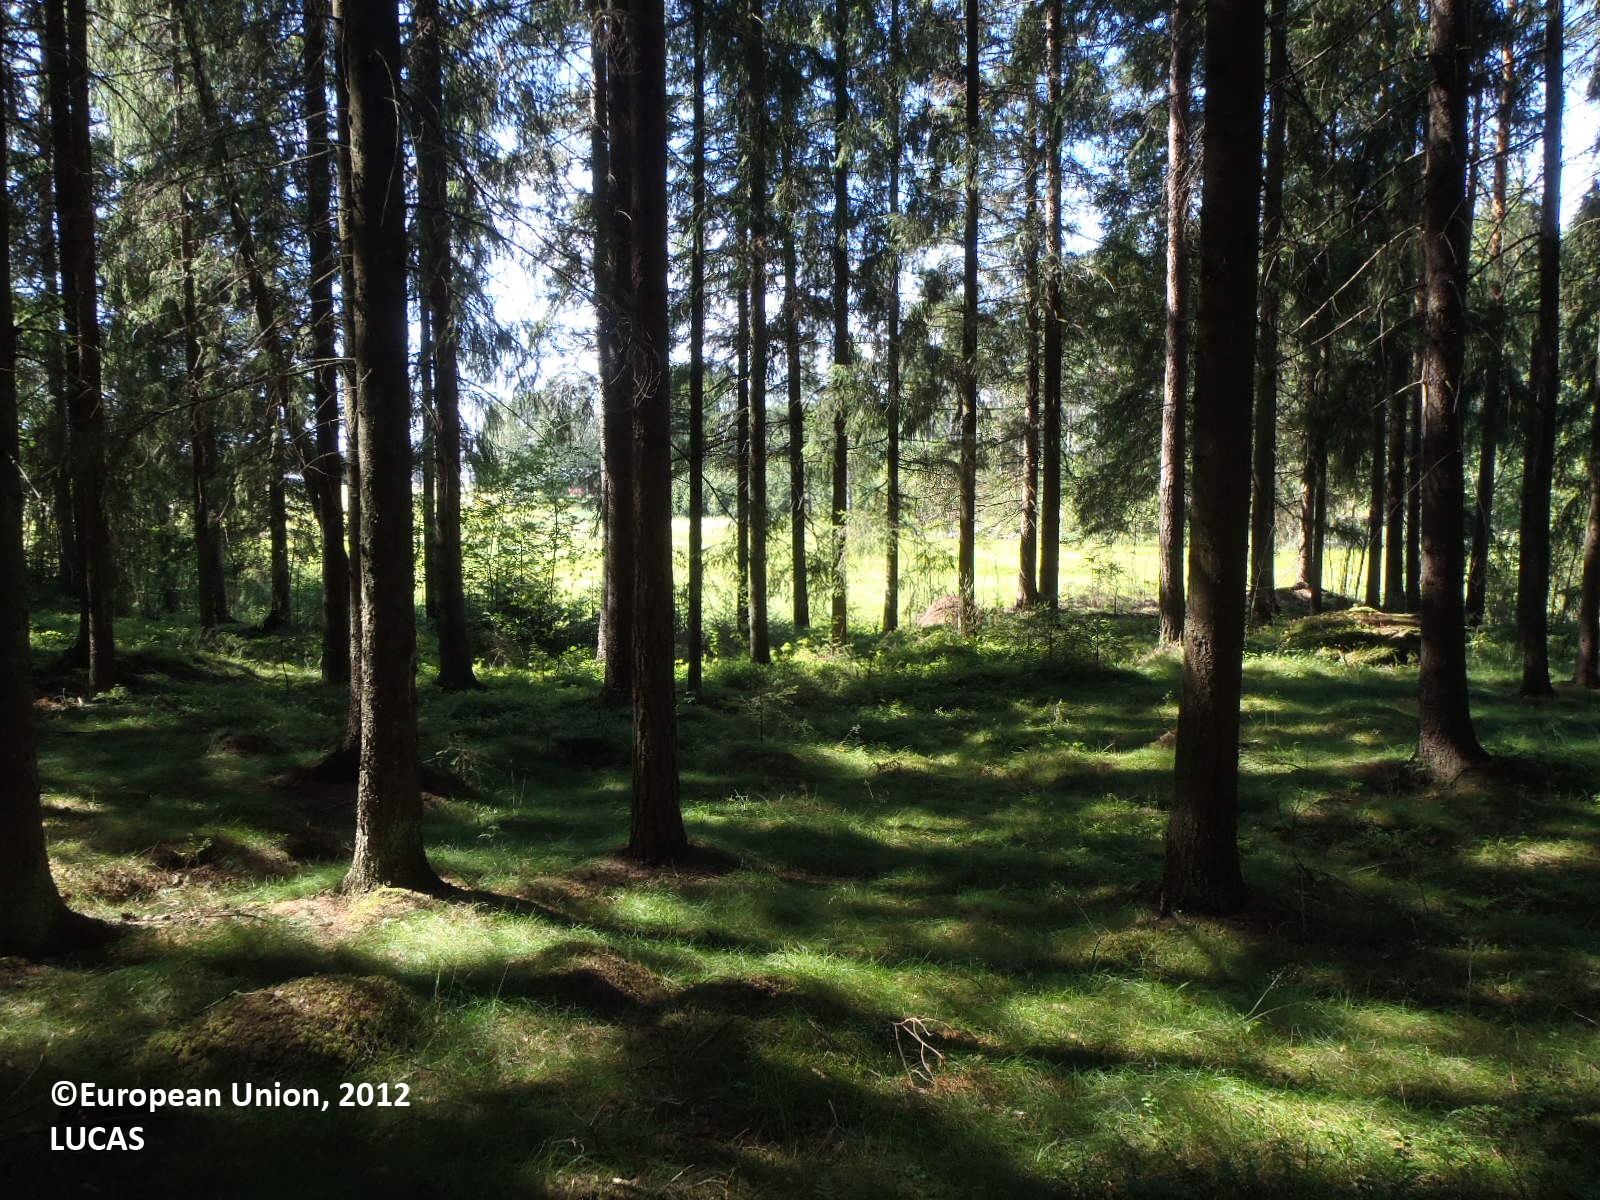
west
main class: Woodland
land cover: Other coniferous woodland
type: boreal forest
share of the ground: > 75 %
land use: Forestry
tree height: > 5 m
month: July
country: FI
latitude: 60.7103
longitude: 21.7309
